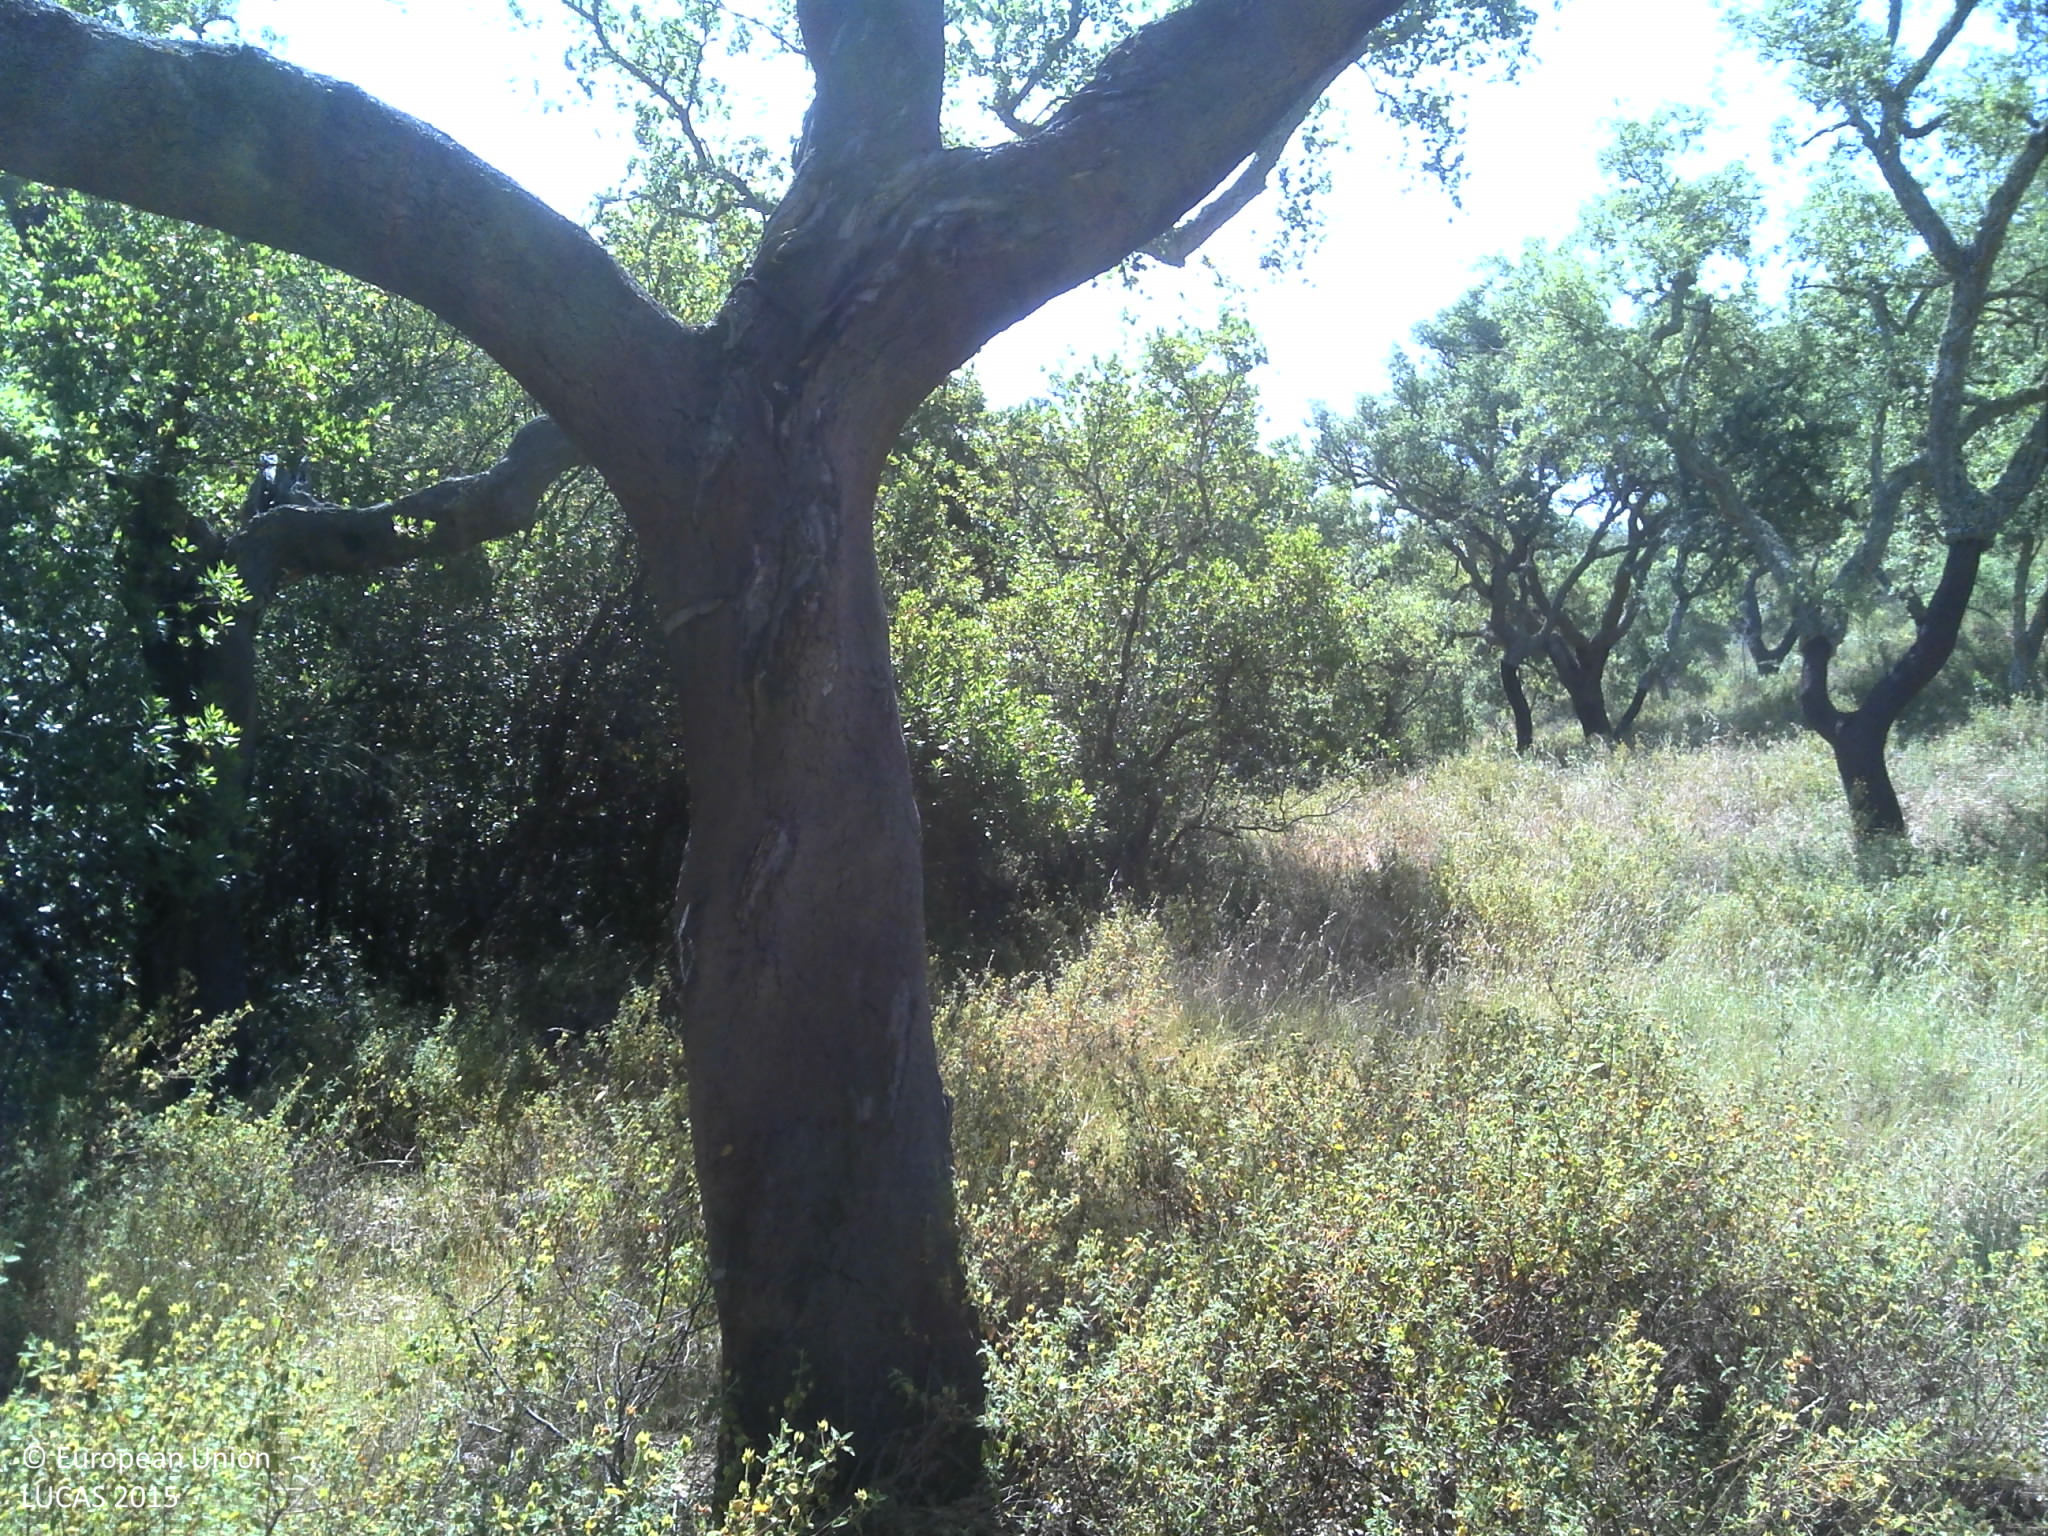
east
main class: Woodland
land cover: Broadleaved woodland
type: broadleaved evergreen forest
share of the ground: 25 - 50 %
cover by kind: shrubs 40 %, broadleaved forest trees 35 %, herbaceous plants 15 %, unconsolidated bare surface 10 %
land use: Forestry
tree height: > 5 m
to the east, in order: Broadleaved woodland; Rivers and streams; Broadleaved woodland; Rivers and streams; Broadleaved woodland
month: May
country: PT
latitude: 38.0652
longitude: -8.5914
